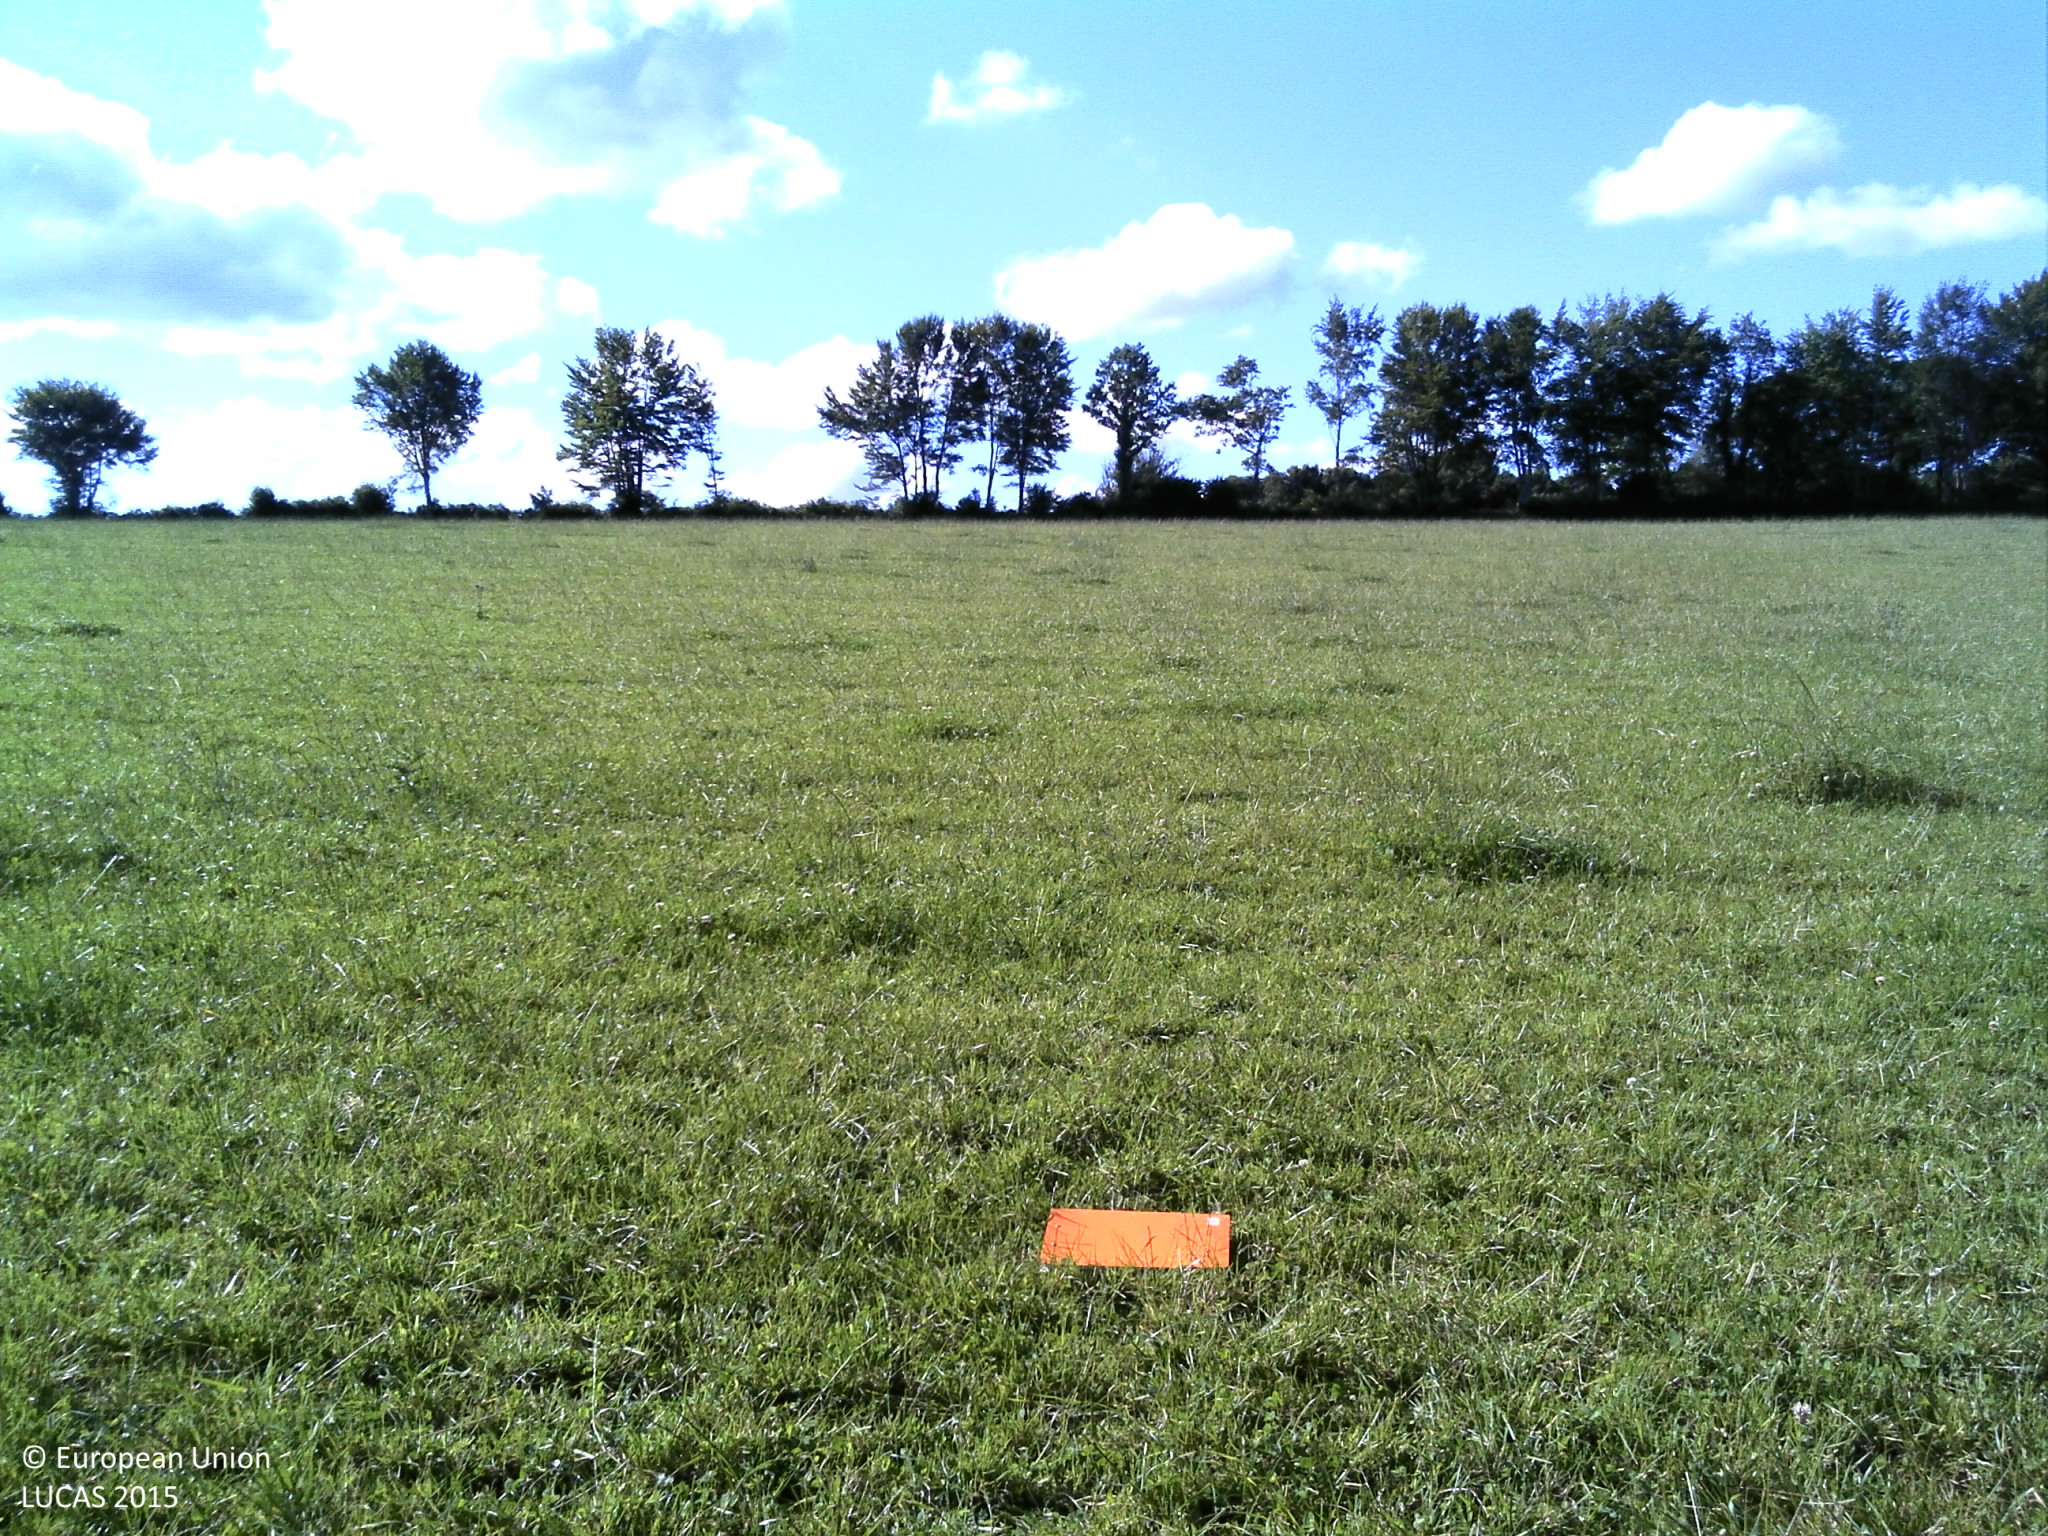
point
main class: Grassland
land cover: Grassland without tree/shrub cover
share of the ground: > 75 %
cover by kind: herbaceous plants 100 %
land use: Agriculture (excluding fallow land and kitchen gardens)
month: July
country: FR
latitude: 48.4724
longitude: -3.7314
